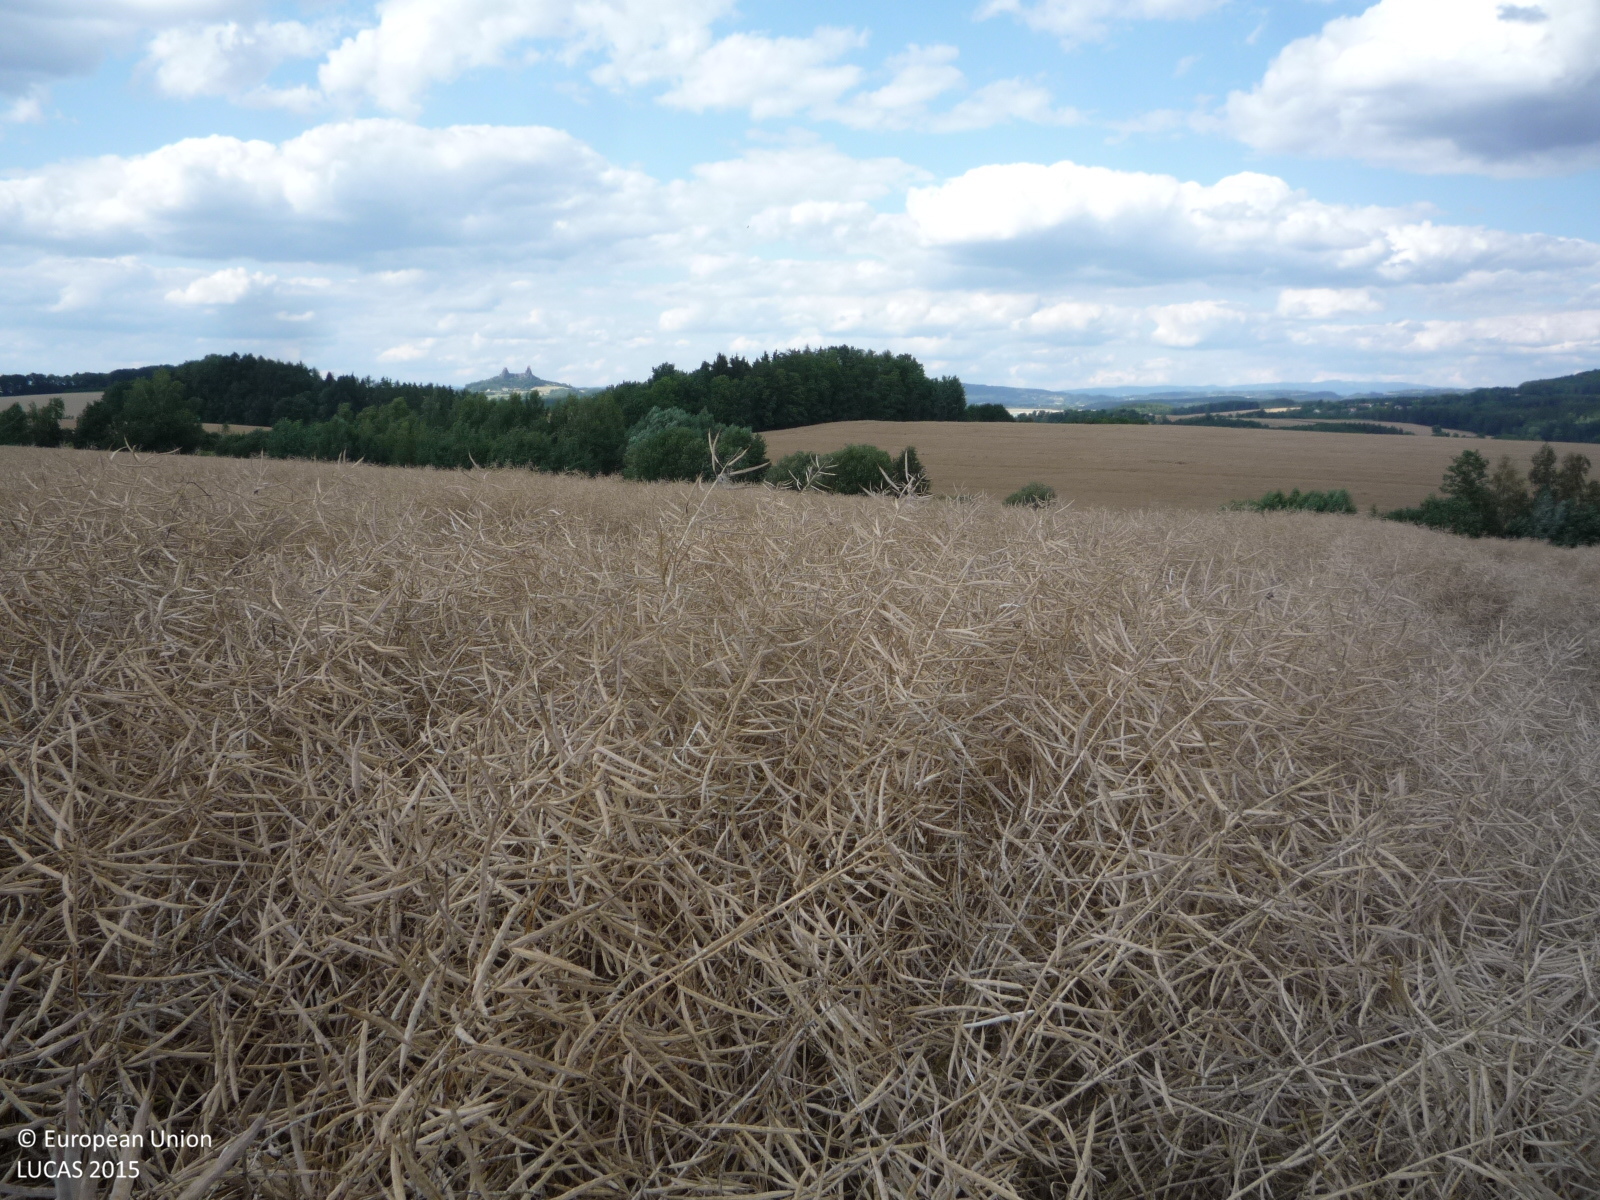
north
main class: Cropland
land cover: Rape and turnip rape
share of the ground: > 75 %
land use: Agriculture (excluding fallow land and kitchen gardens)
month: July
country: CZ
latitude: 50.4607
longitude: 15.2295
